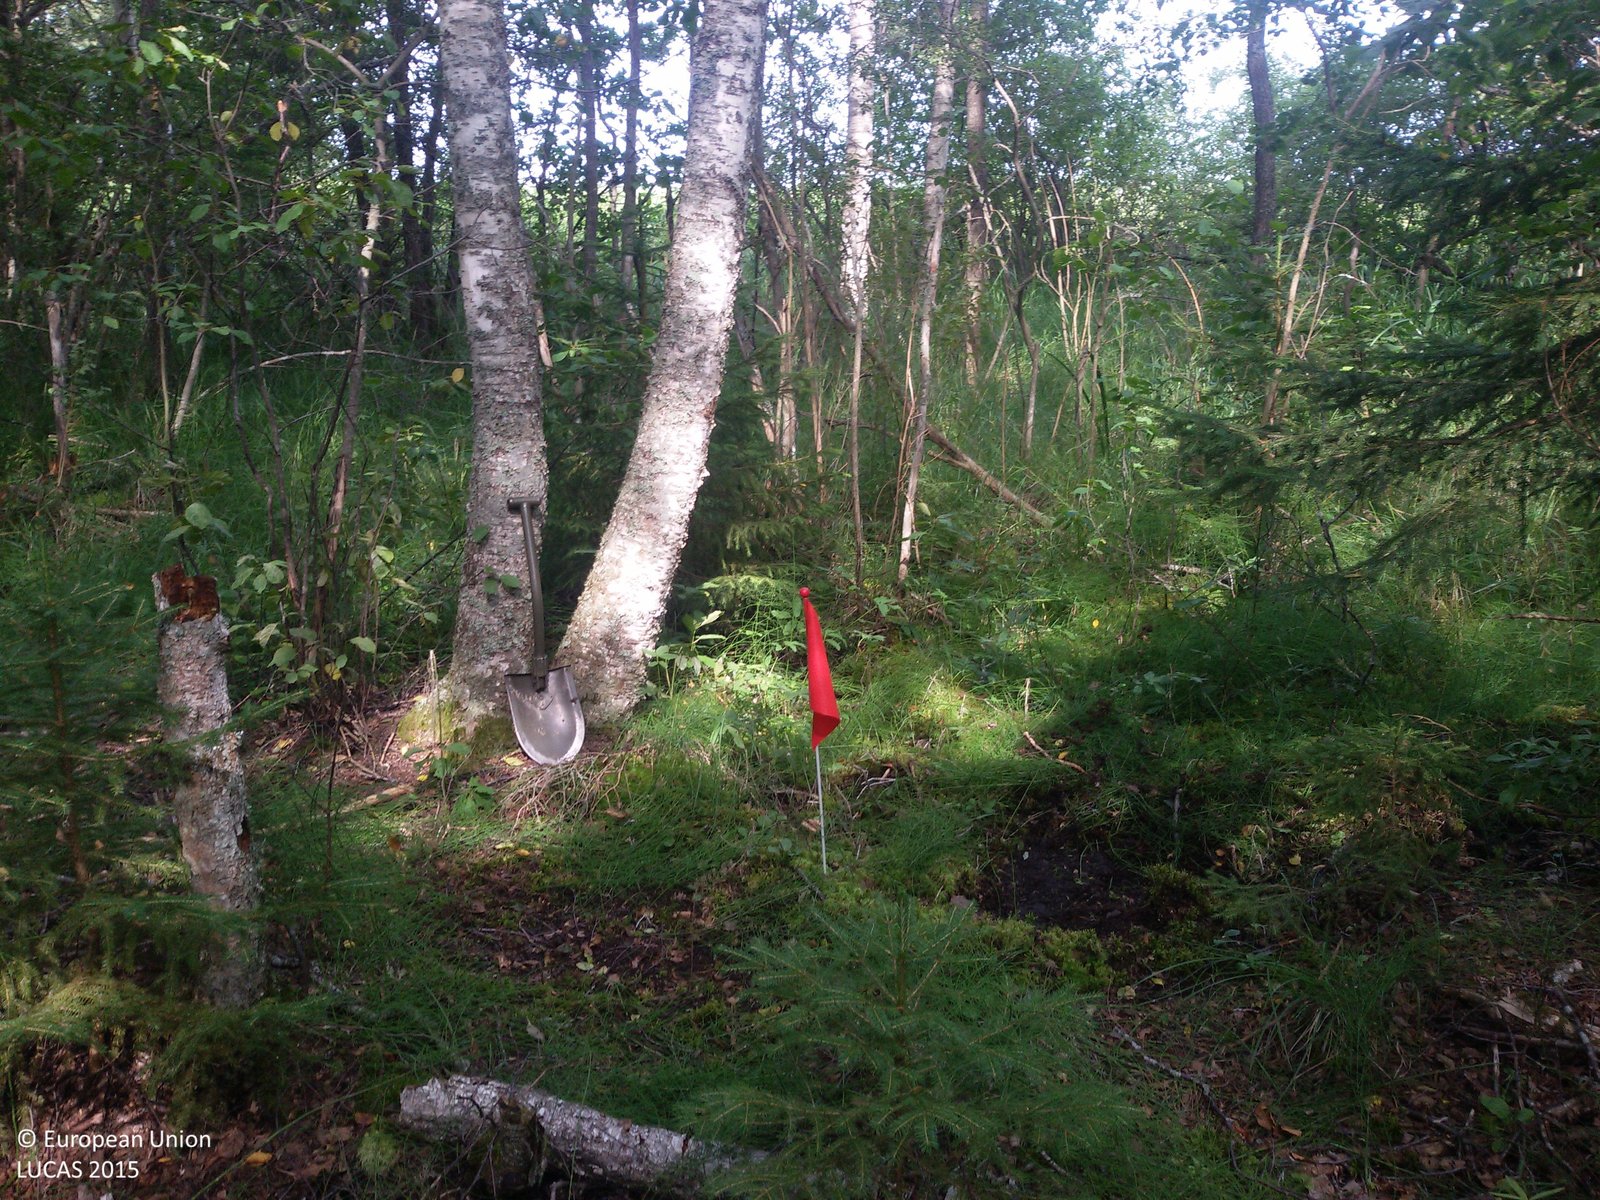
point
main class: Woodland
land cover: Pine dominated mixed woodland
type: hemiboreal forest and nemoral coniferous forest and mixed broadleaved-coniferous forest
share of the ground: > 75 %
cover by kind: broadleaved forest trees 60 %, coniferous forest trees 25 %, herbaceous plants 10 %, lichens and mosses 5 %
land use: Semi-natural and natural areas not in use
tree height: > 5 m
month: August
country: SE
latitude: 60.4767
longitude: 16.6291
